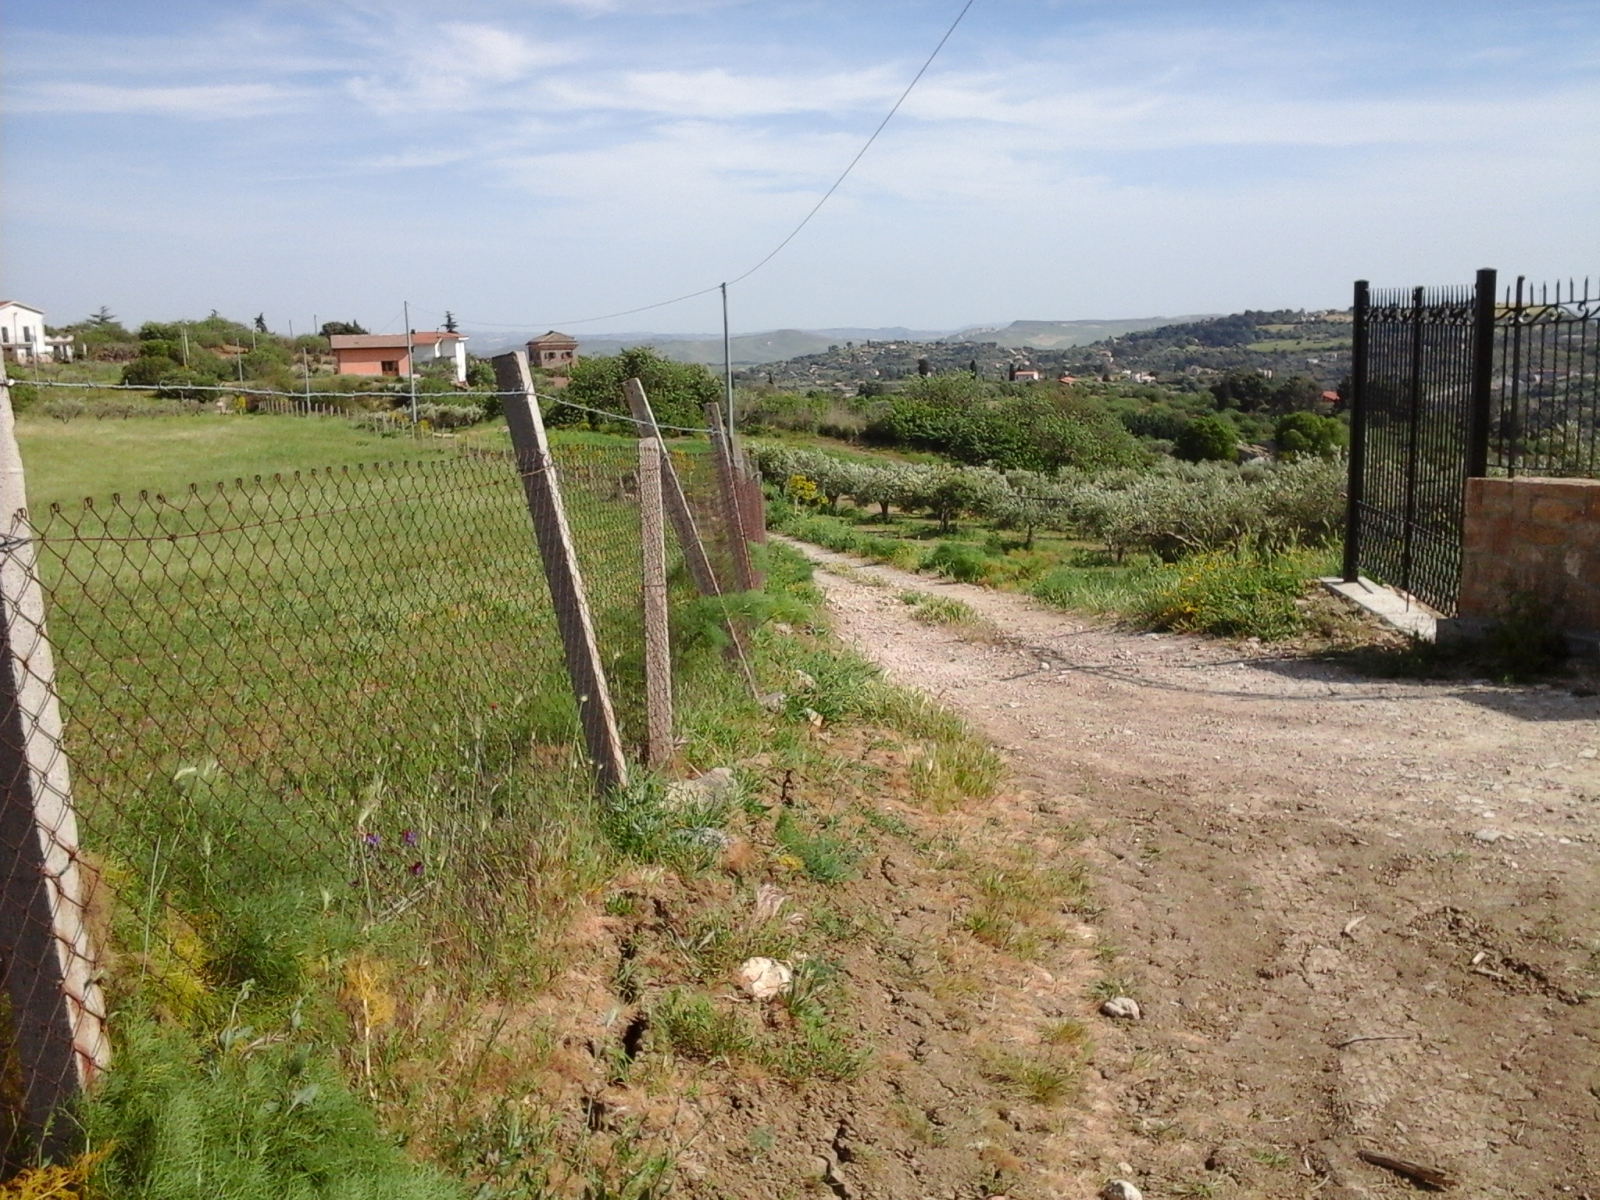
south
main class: Grassland
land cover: Spontaneously vegetated surfaces
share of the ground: > 75 %
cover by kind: herbaceous plants 100 %
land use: Fallow land
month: May
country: IT
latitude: 37.4813
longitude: 14.0071
